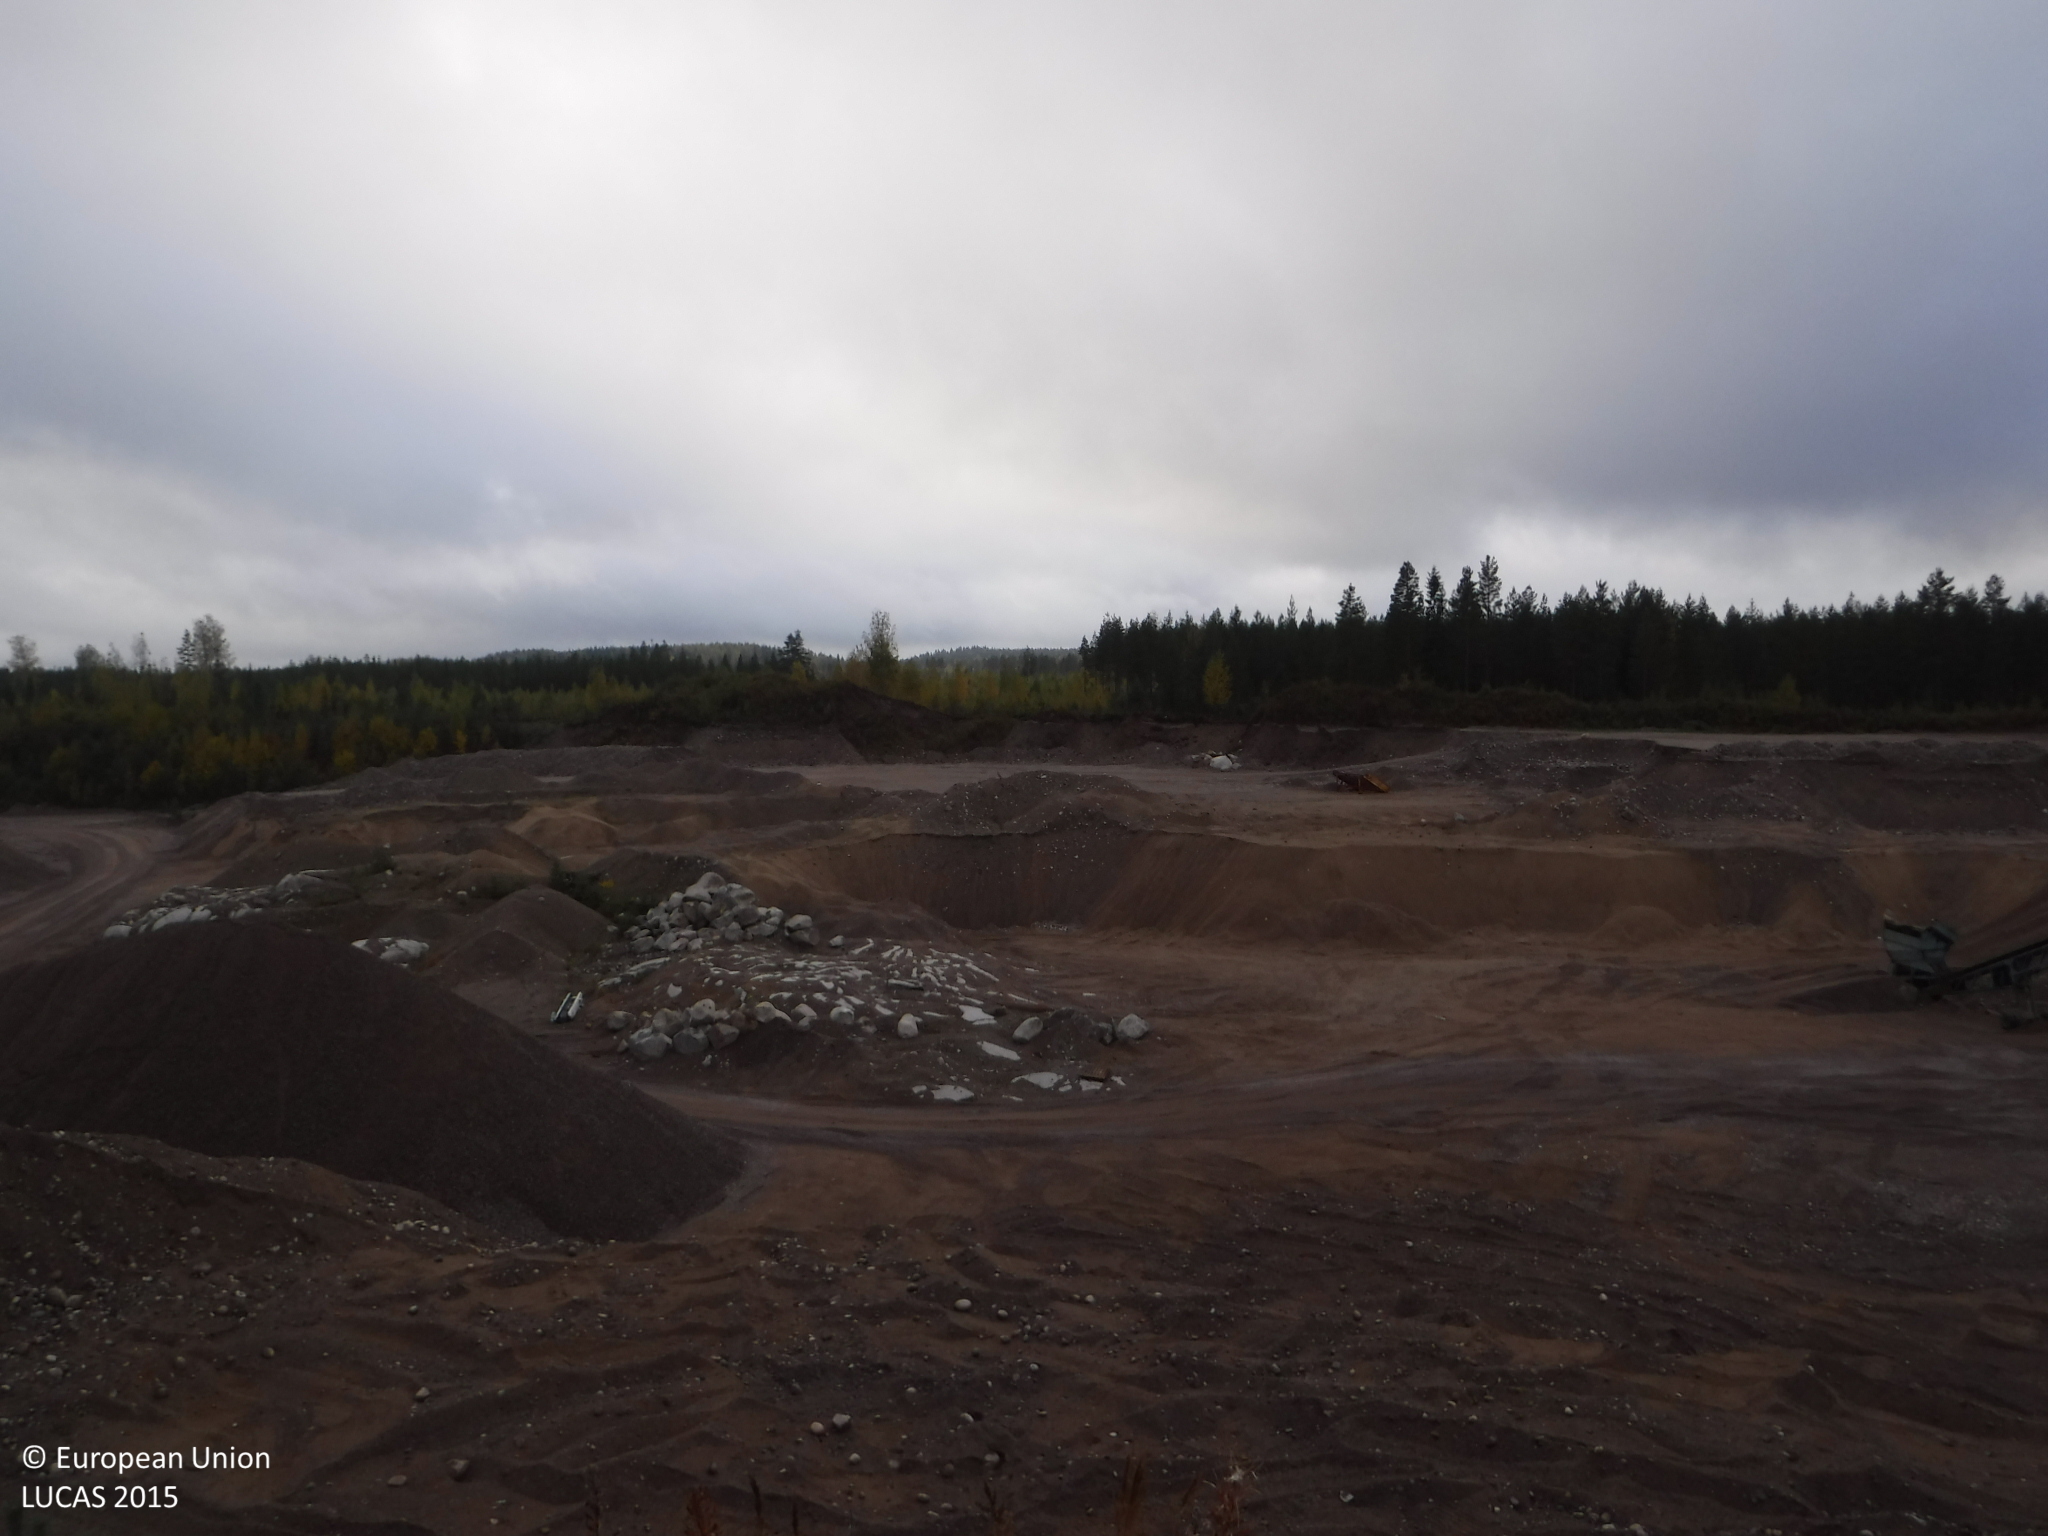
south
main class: Grassland
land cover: Grassland without tree/shrub cover
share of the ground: > 75 %
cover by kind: herbaceous plants 100 %
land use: Mining and quarrying
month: September
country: FI
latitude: 61.8636
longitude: 24.1745
